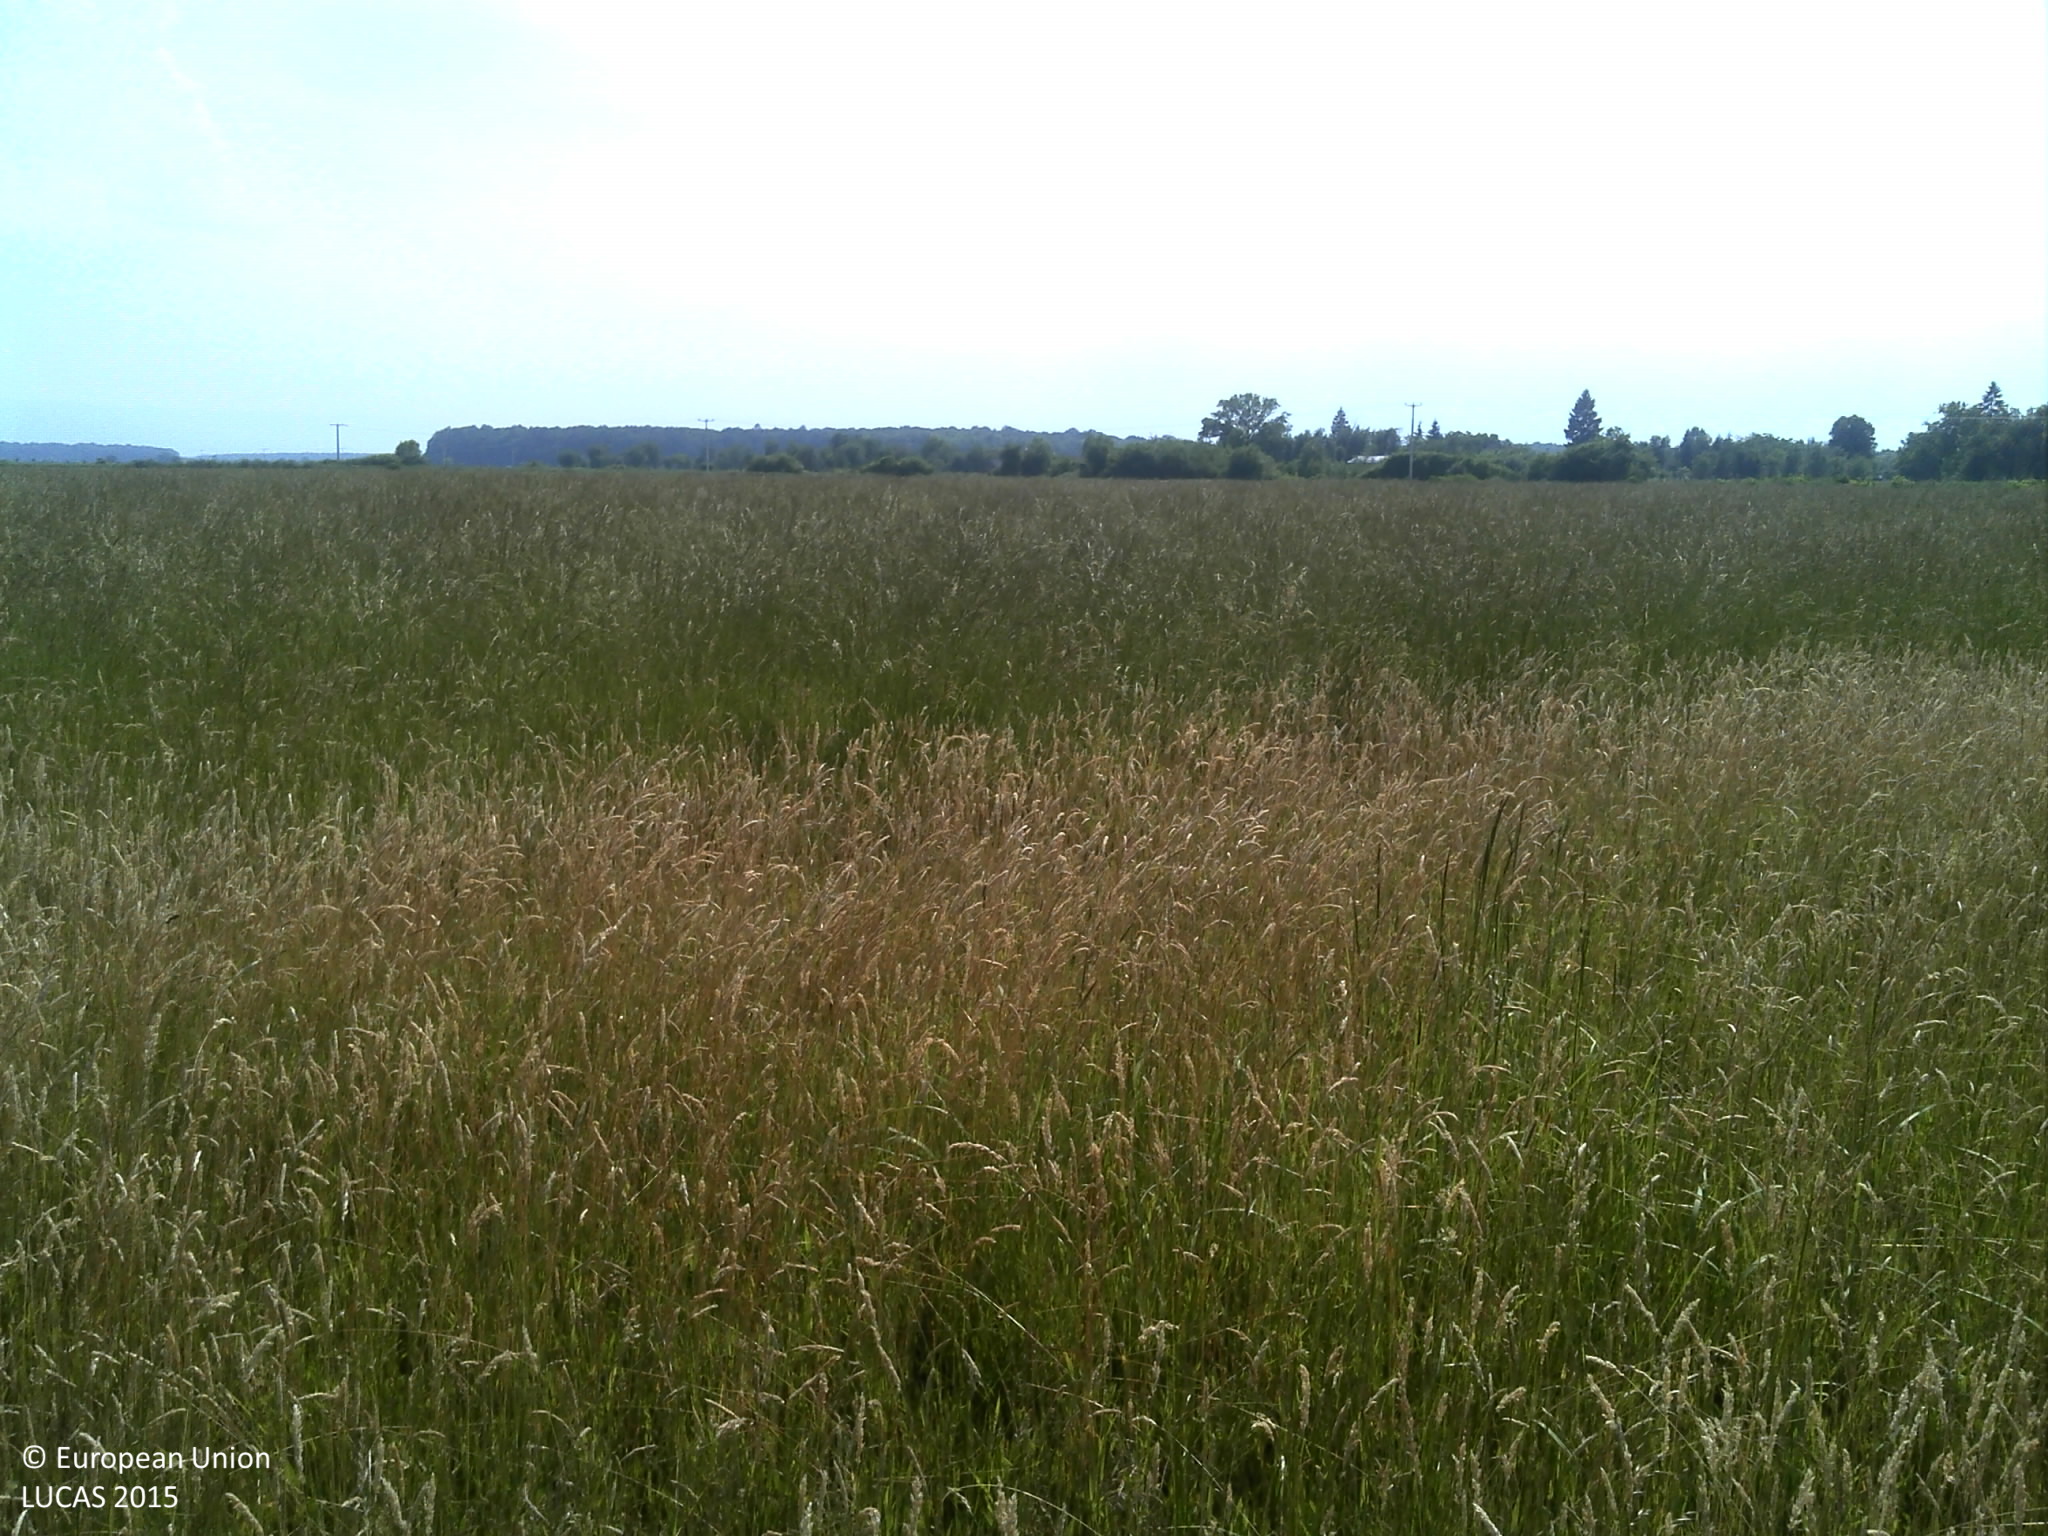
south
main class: Grassland
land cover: Spontaneously vegetated surfaces
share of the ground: > 75 %
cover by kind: herbaceous plants 100 %
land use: Fallow land
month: June
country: HR
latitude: 45.7004
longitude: 17.8511
